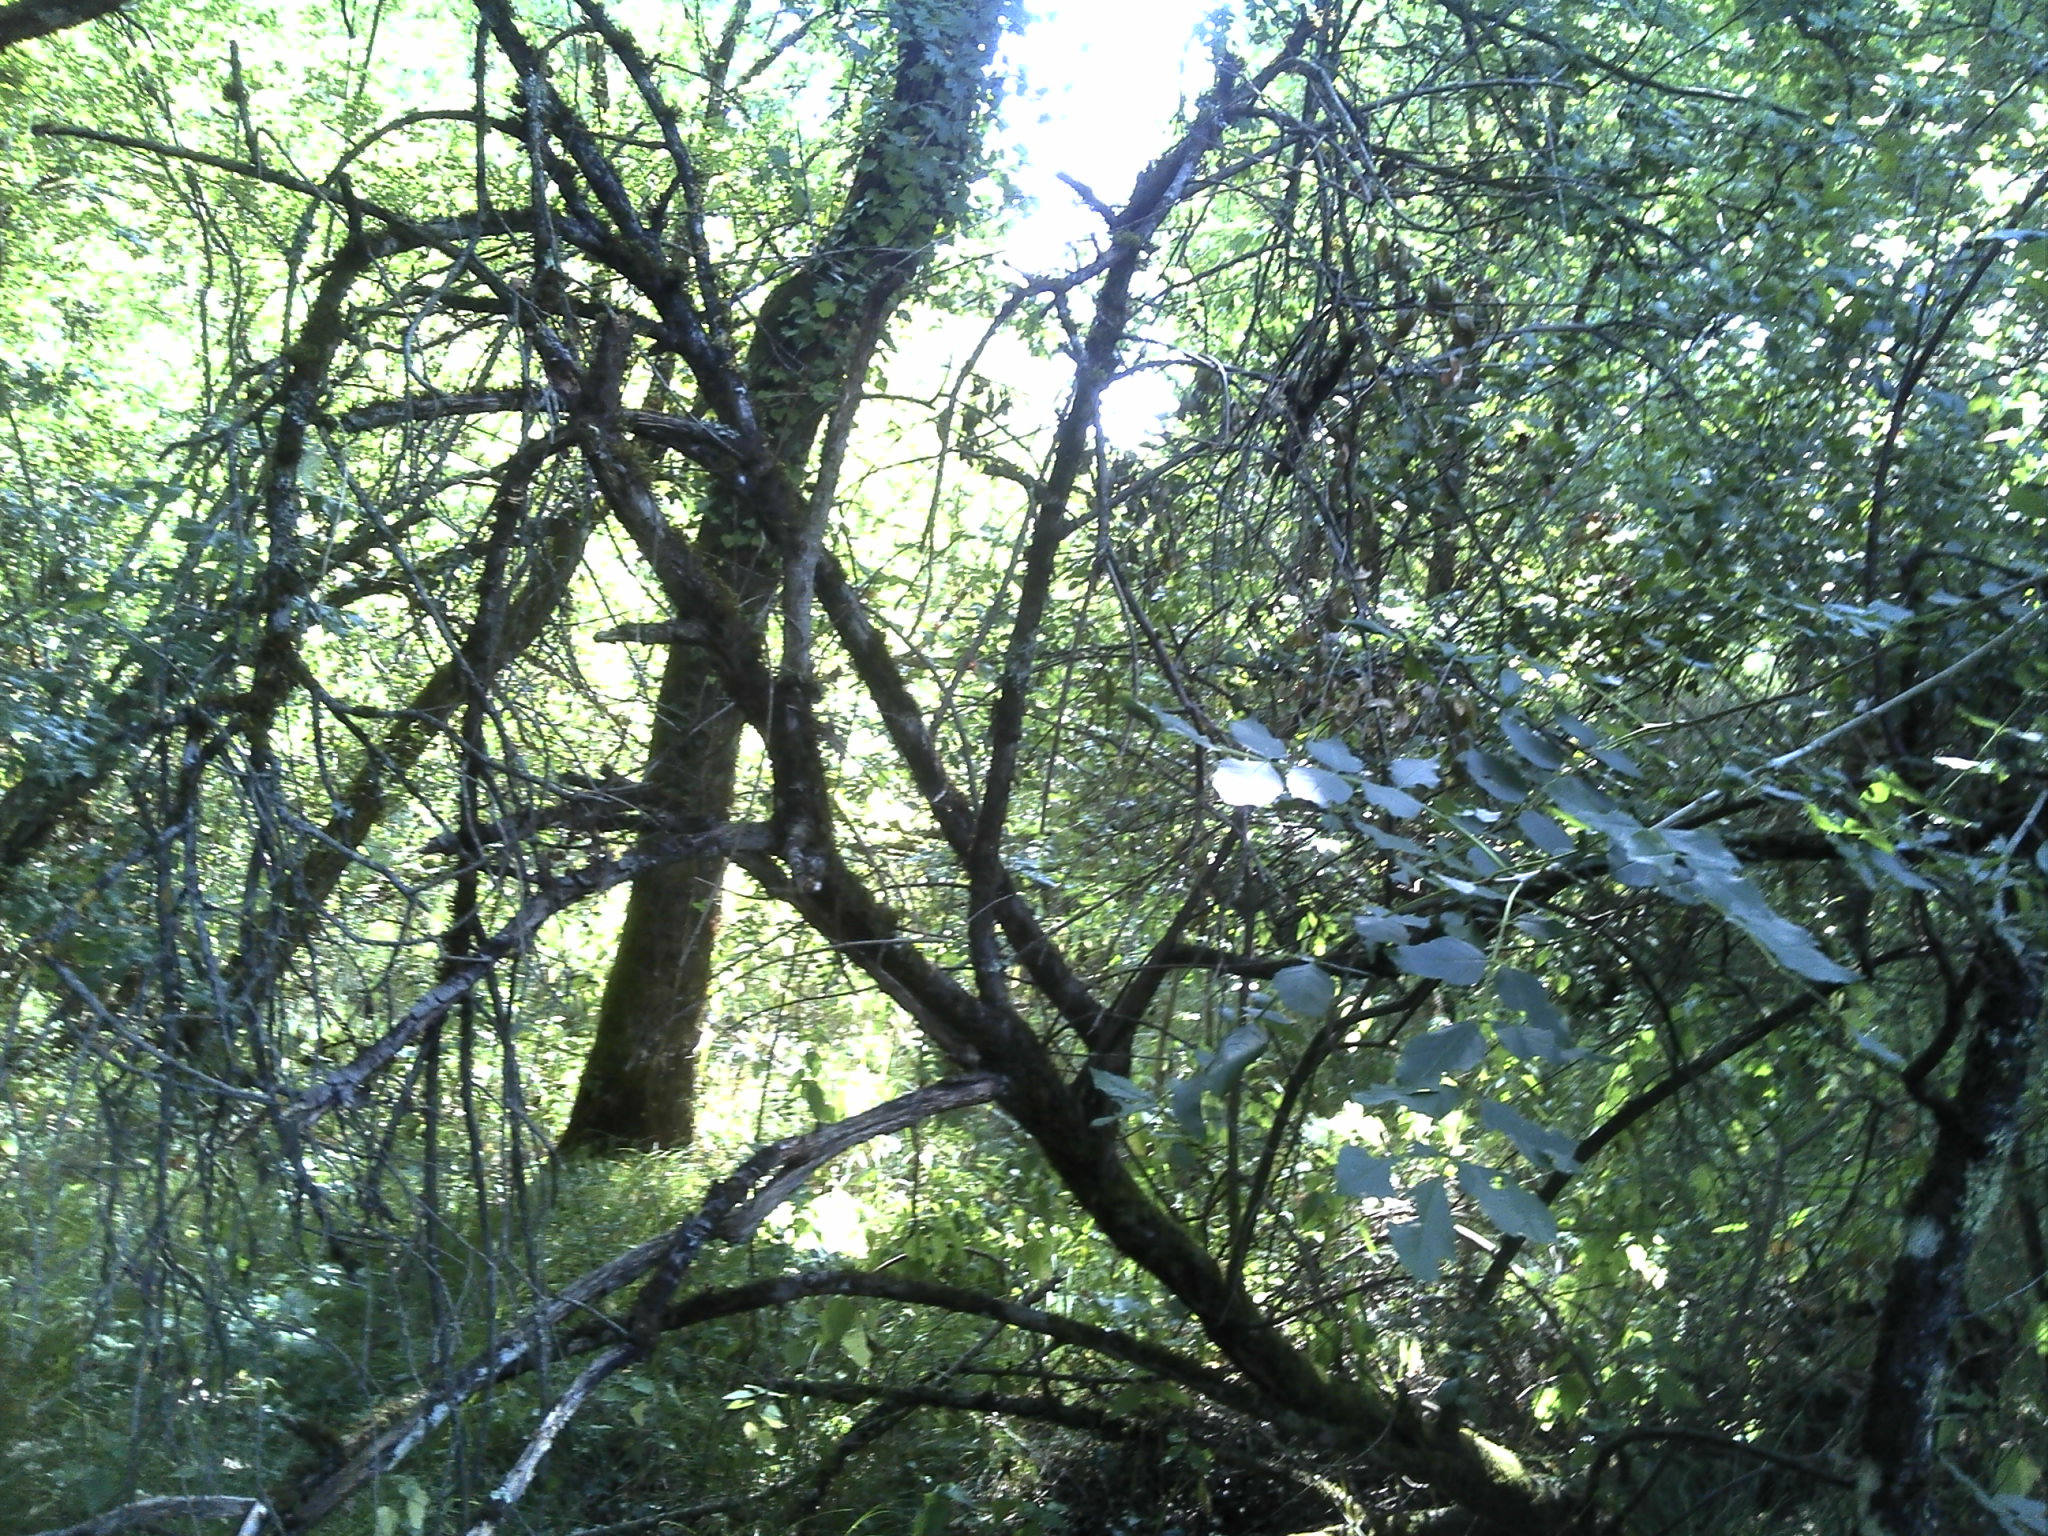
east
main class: Woodland
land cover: Broadleaved woodland
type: mesophytic deciduous forest
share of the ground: > 75 %
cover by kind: broadleaved forest trees 95 %, herbaceous plants 5 %
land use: Forestry
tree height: > 5 m
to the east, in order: Broadleaved woodland; Artificial constructions in urban areas; Ditches and canals; Fences; Broadleaved woodland; Fences; Grassland with sparse tree/shrub cover; Broadleaved woodland; Abandoned hedges; Grassland with sparse tree/shrub cover
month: July
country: FR
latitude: 46.6867
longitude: 1.5560
